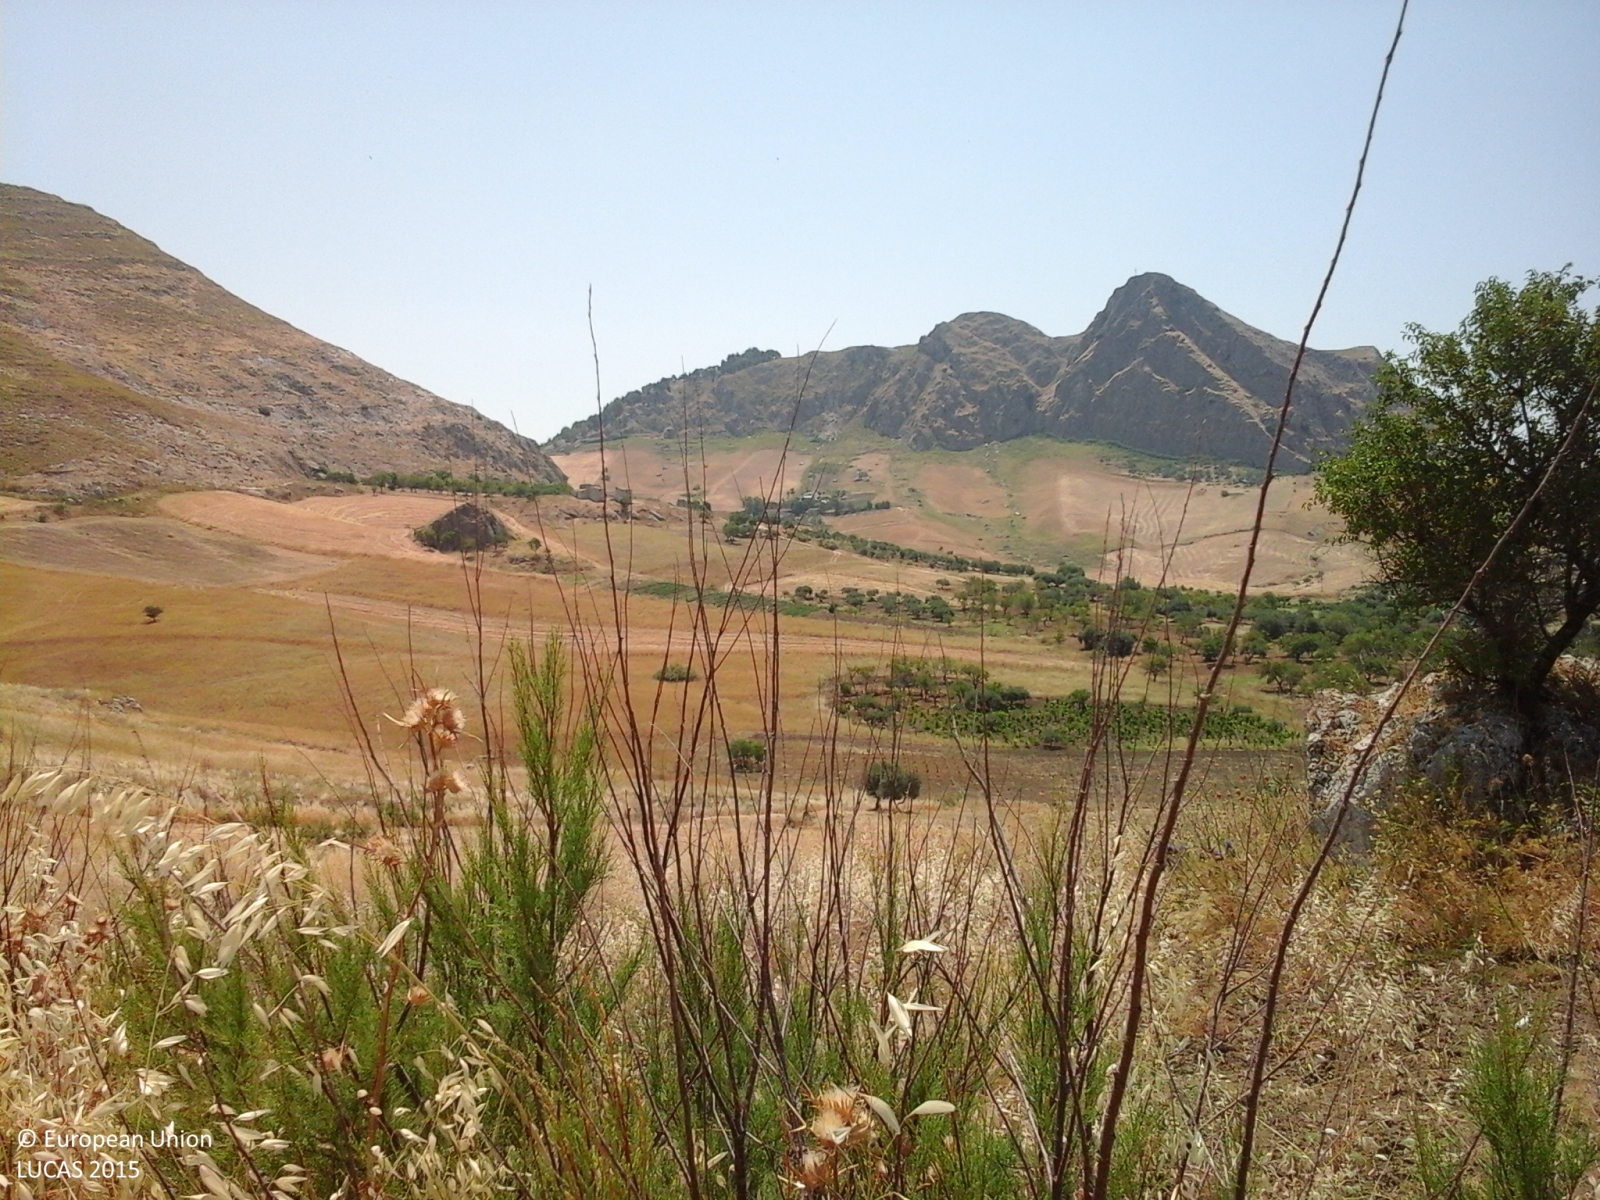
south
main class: Grassland
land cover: Spontaneously vegetated surfaces
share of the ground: > 75 %
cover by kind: herbaceous plants 100 %
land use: Agriculture (excluding fallow land and kitchen gardens)
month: July
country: IT
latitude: 37.4457
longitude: 13.5335
